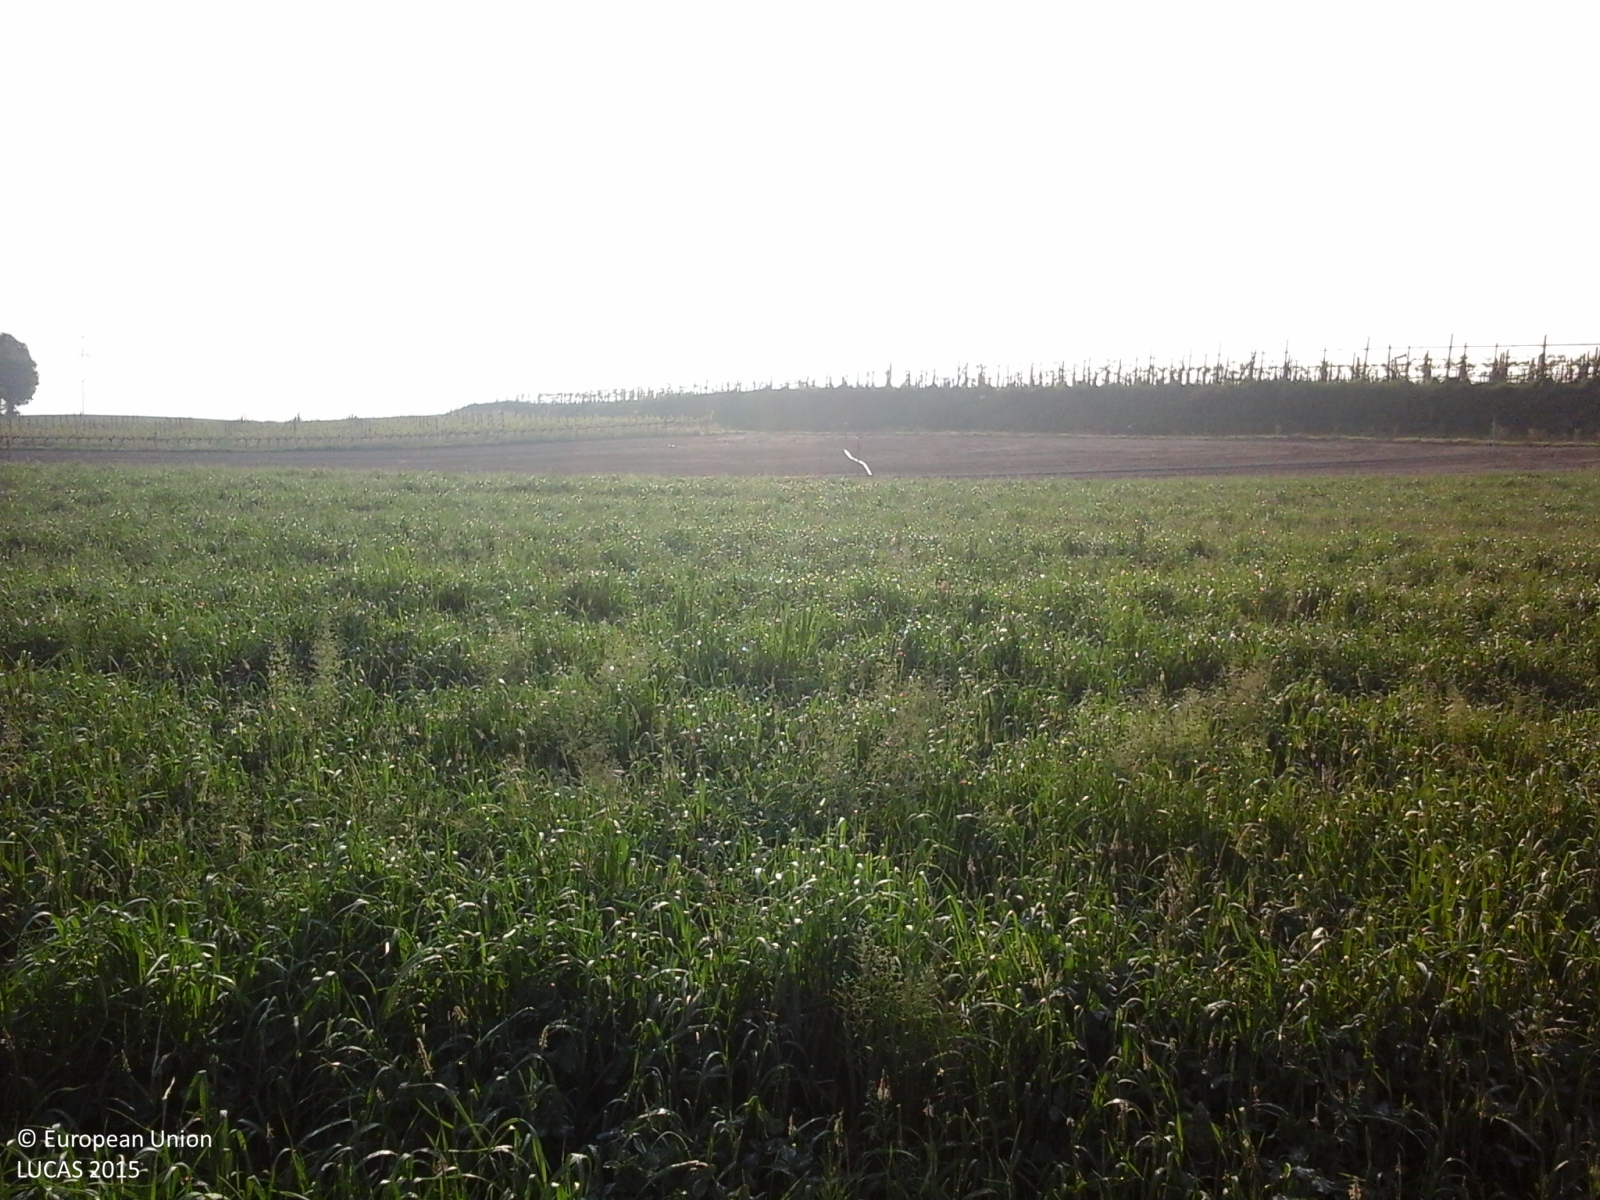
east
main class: Cropland
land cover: Other leguminous and mixtures for fodder
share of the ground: > 75 %
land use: Agriculture (excluding fallow land and kitchen gardens)
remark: Tilled/Sowed
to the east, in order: Other leguminous and mixtures for fodder; Ditches and canals; Maize; Tracks; Grass margins; Vineyards; Tracks
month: April
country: IT
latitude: 45.3938
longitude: 10.7268
